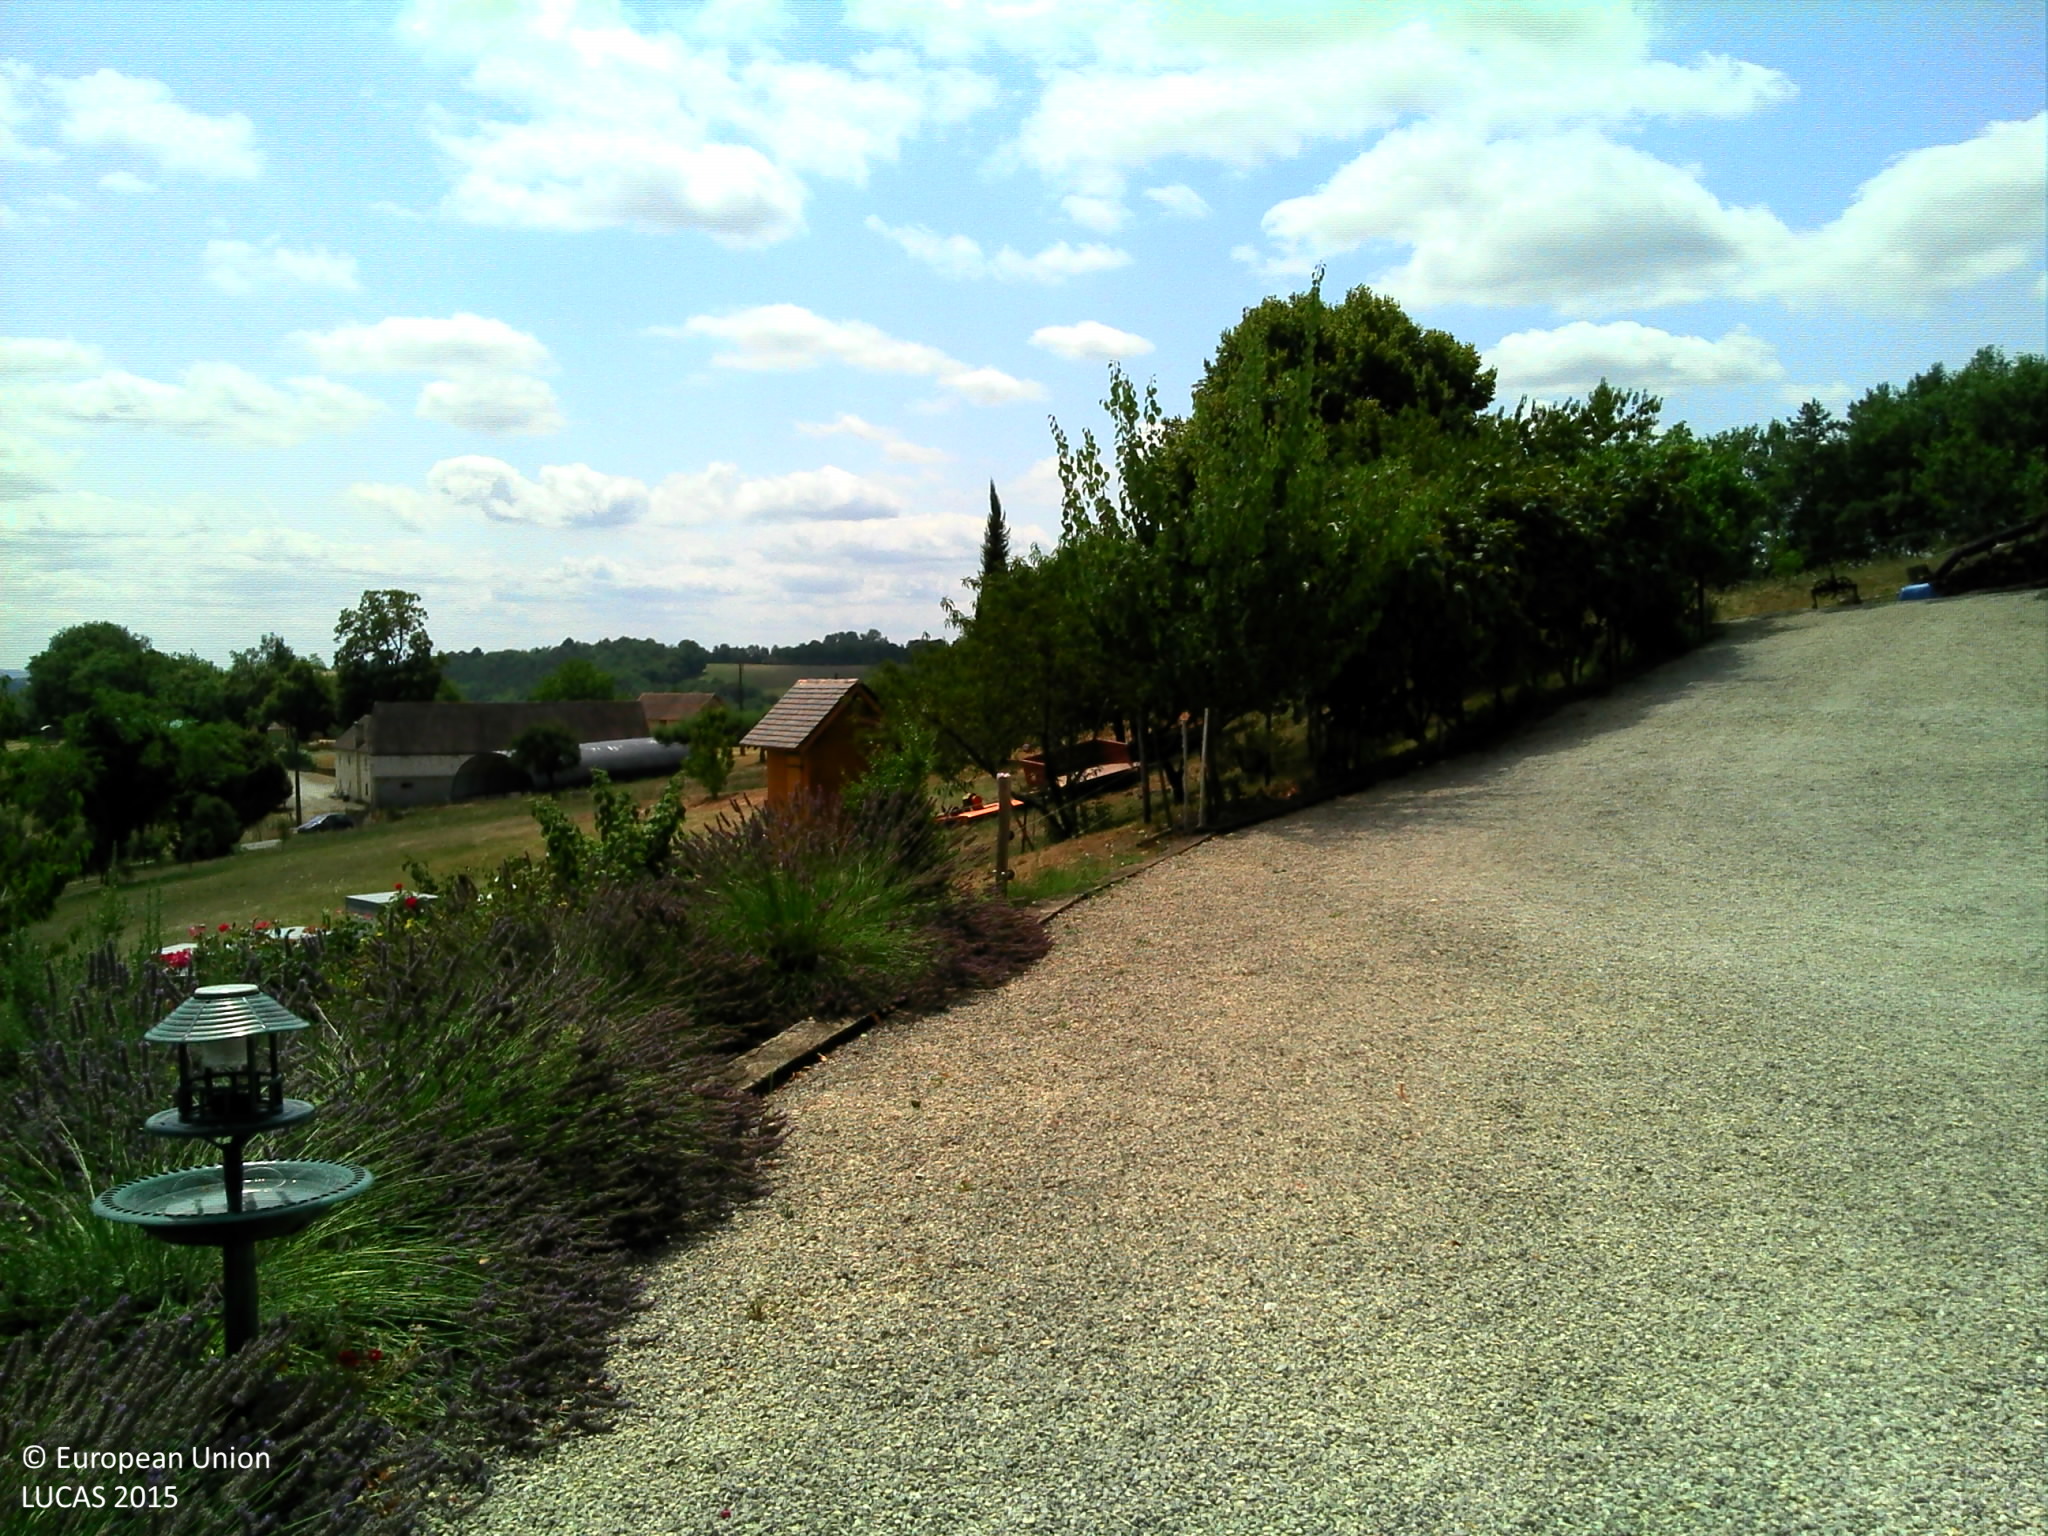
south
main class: Grassland
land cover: Grassland without tree/shrub cover
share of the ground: > 75 %
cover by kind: herbaceous plants 100 %
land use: Agriculture (excluding fallow land and kitchen gardens)
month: July
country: FR
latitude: 45.0905
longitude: 1.0862
